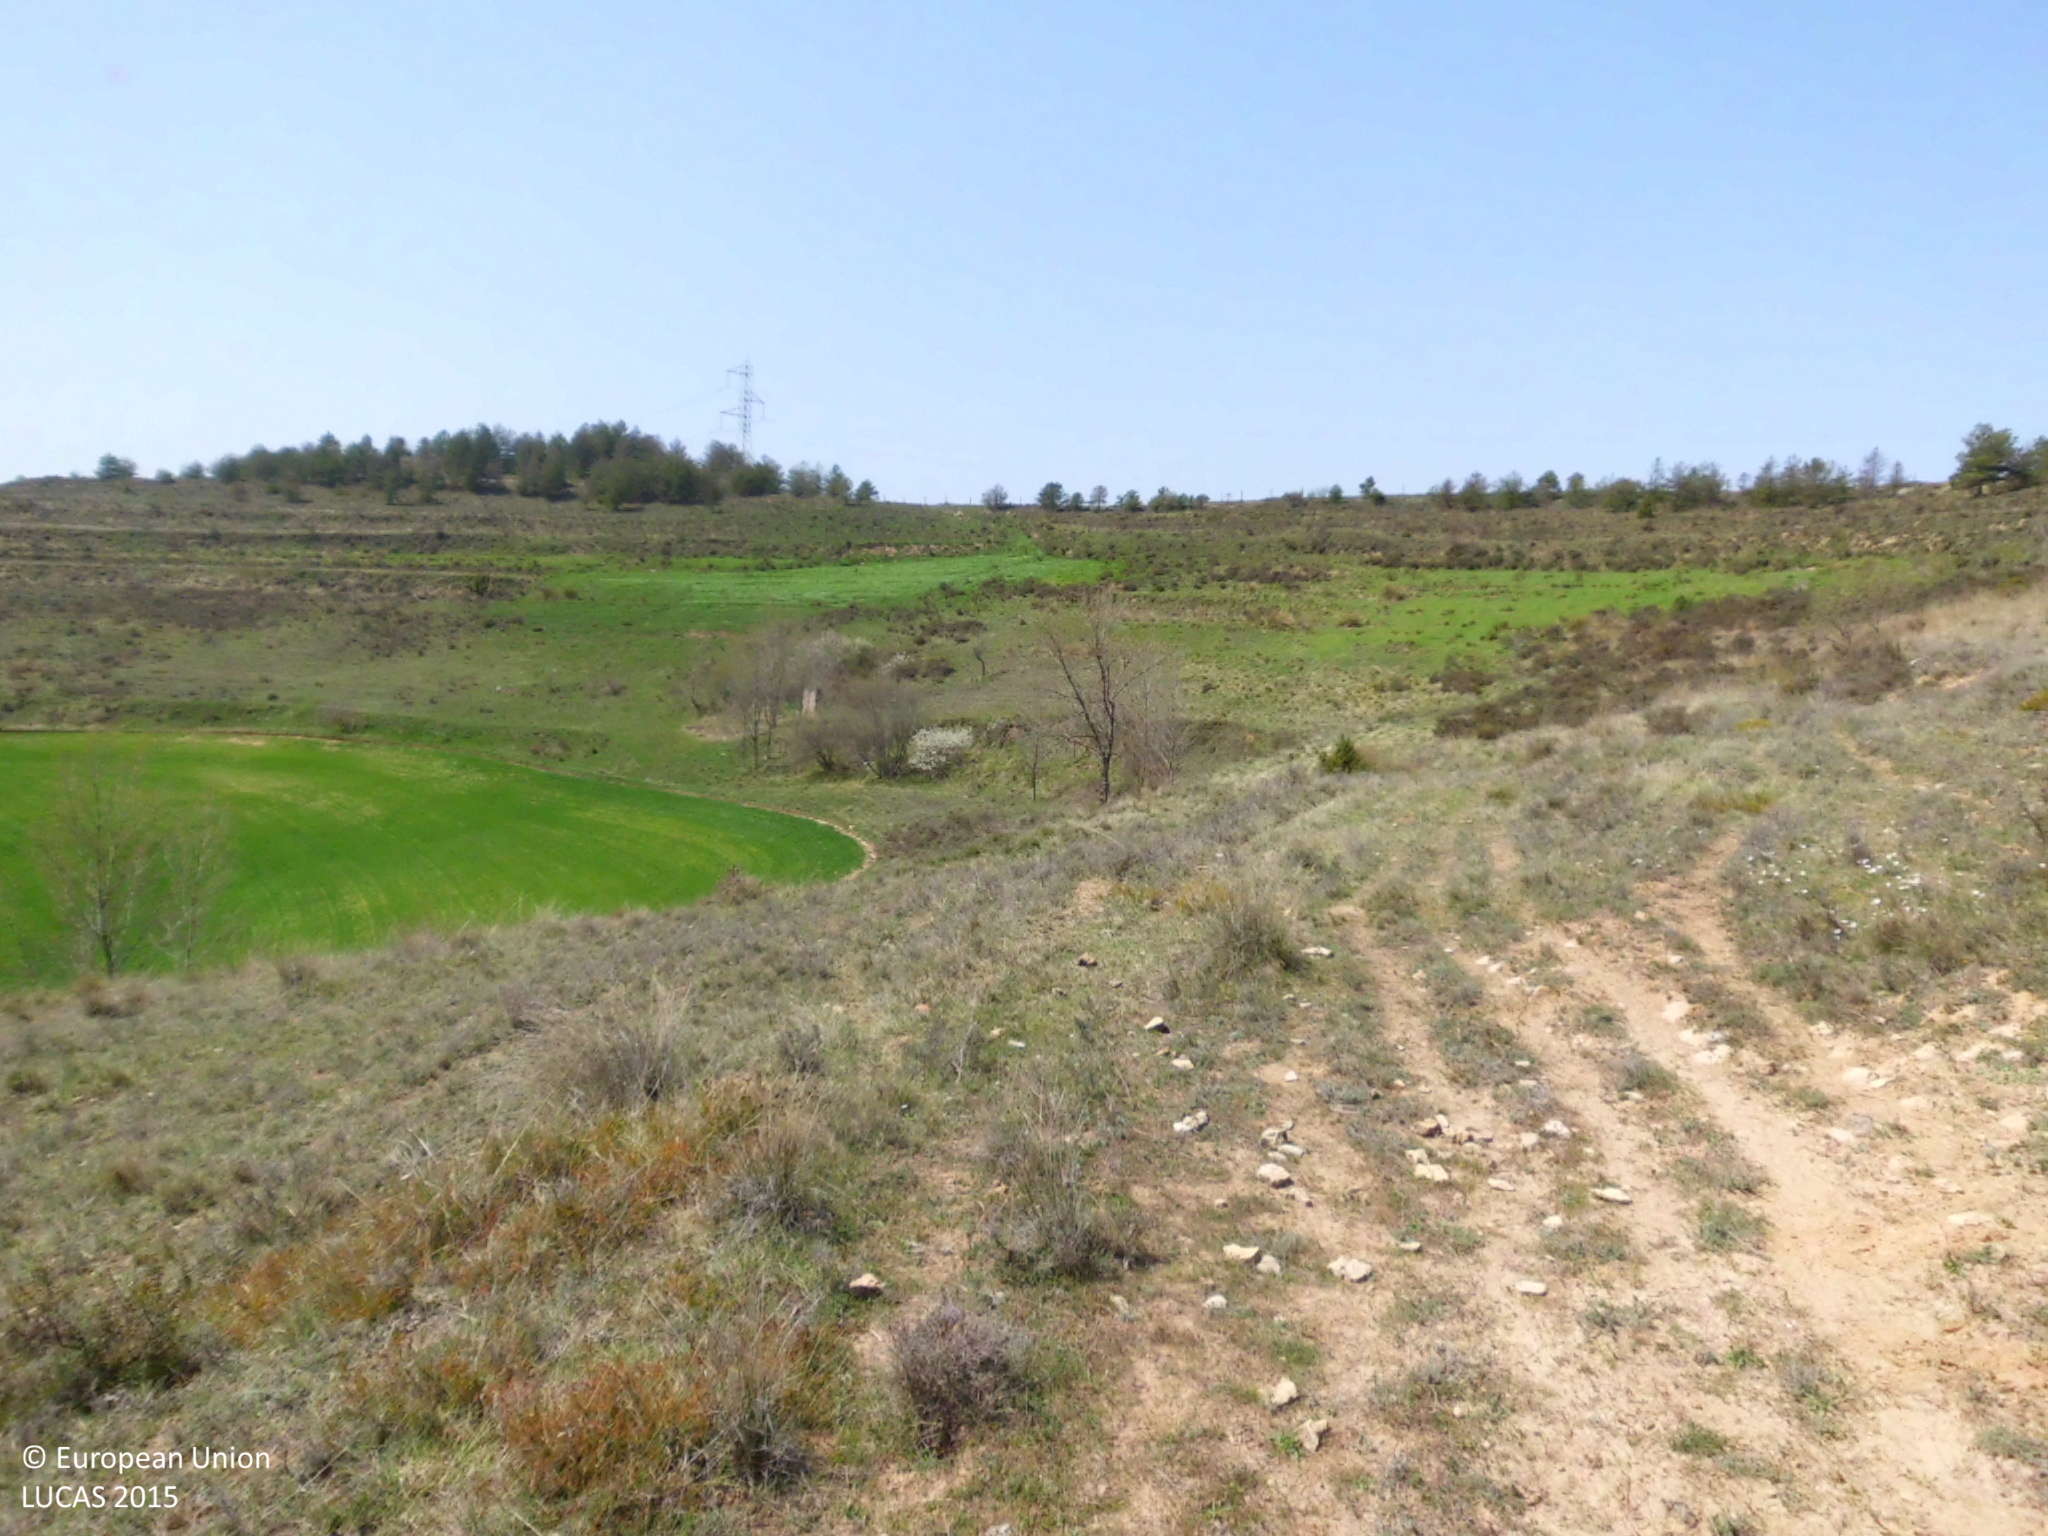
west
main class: Grassland
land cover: Grassland without tree/shrub cover
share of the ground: 50 - 75 %
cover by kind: herbaceous plants 60 %, unconsolidated bare surface 25 %, consolidated bare surface 10 %, shrubs 5 %
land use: Abandoned areas
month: April
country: ES
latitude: 42.5526
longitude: -3.3445
